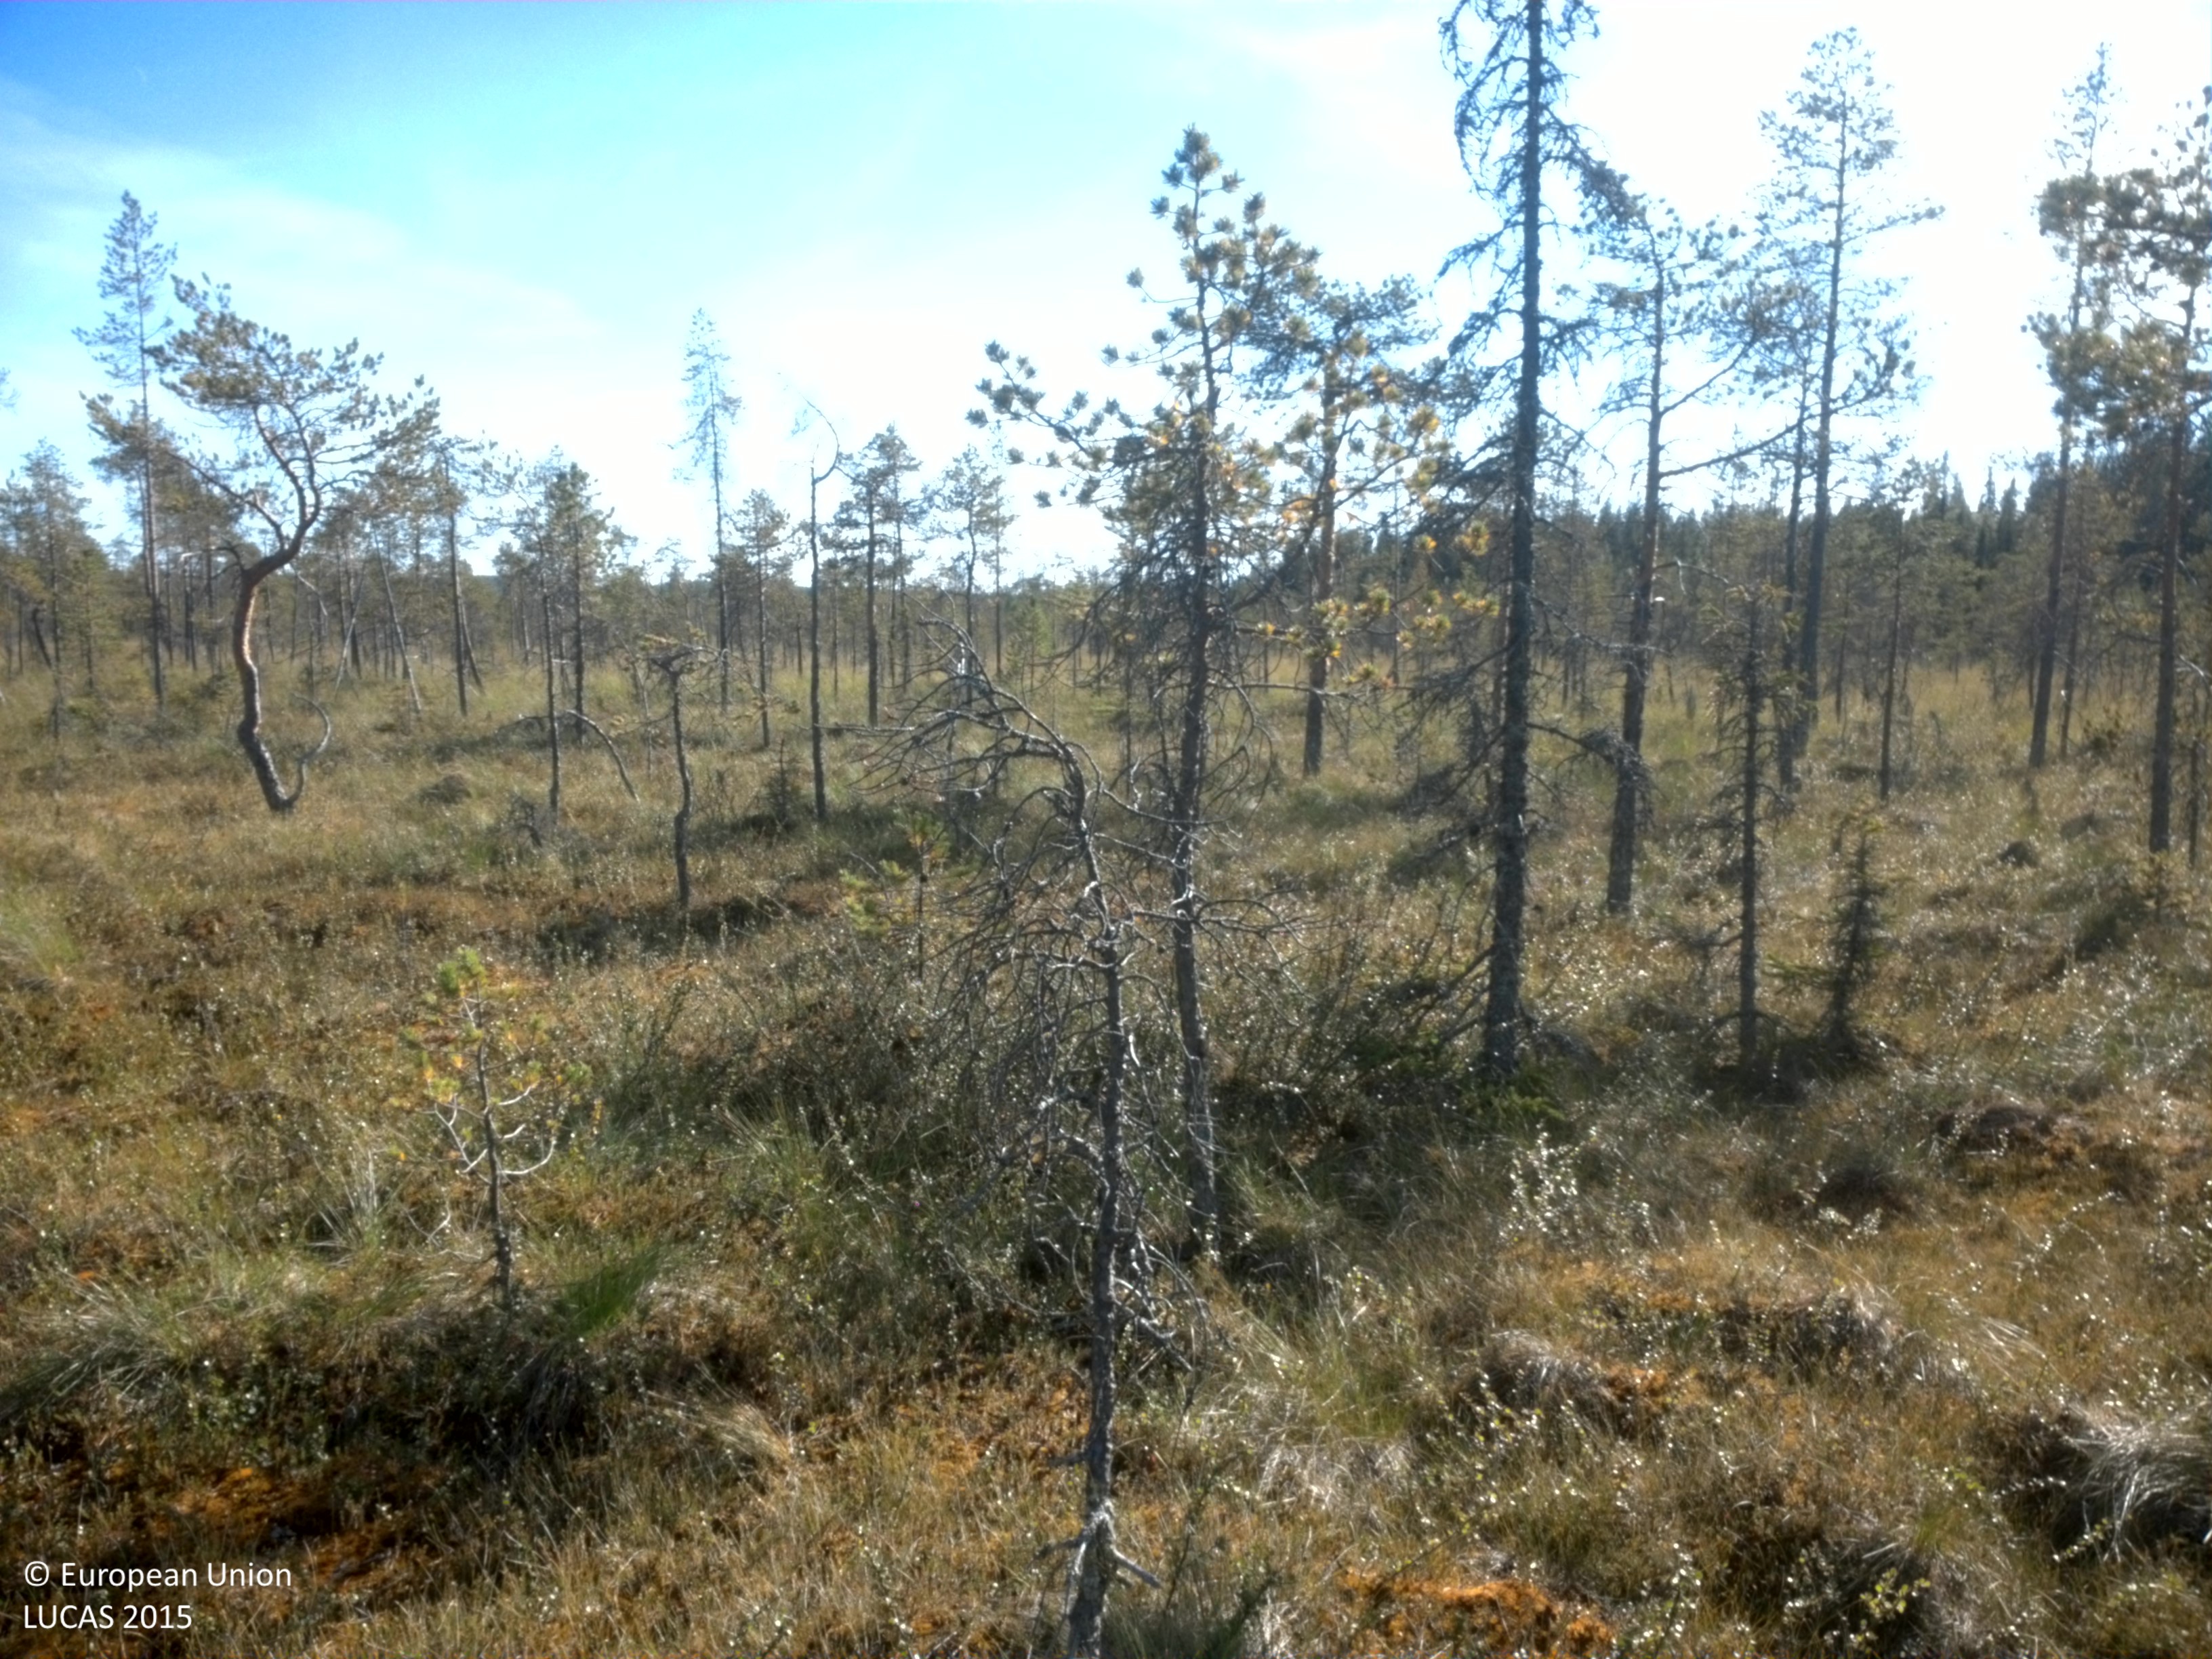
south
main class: Woodland
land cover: Pine dominated coniferous woodland
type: boreal forest
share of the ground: 25 - 50 %
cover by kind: coniferous forest trees 35 %, herbaceous plants 25 %, shrubs 20 %, lichens and mosses 20 %
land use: Semi-natural and natural areas not in use
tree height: > 5 m
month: August
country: SE
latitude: 64.5183
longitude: 18.4469
